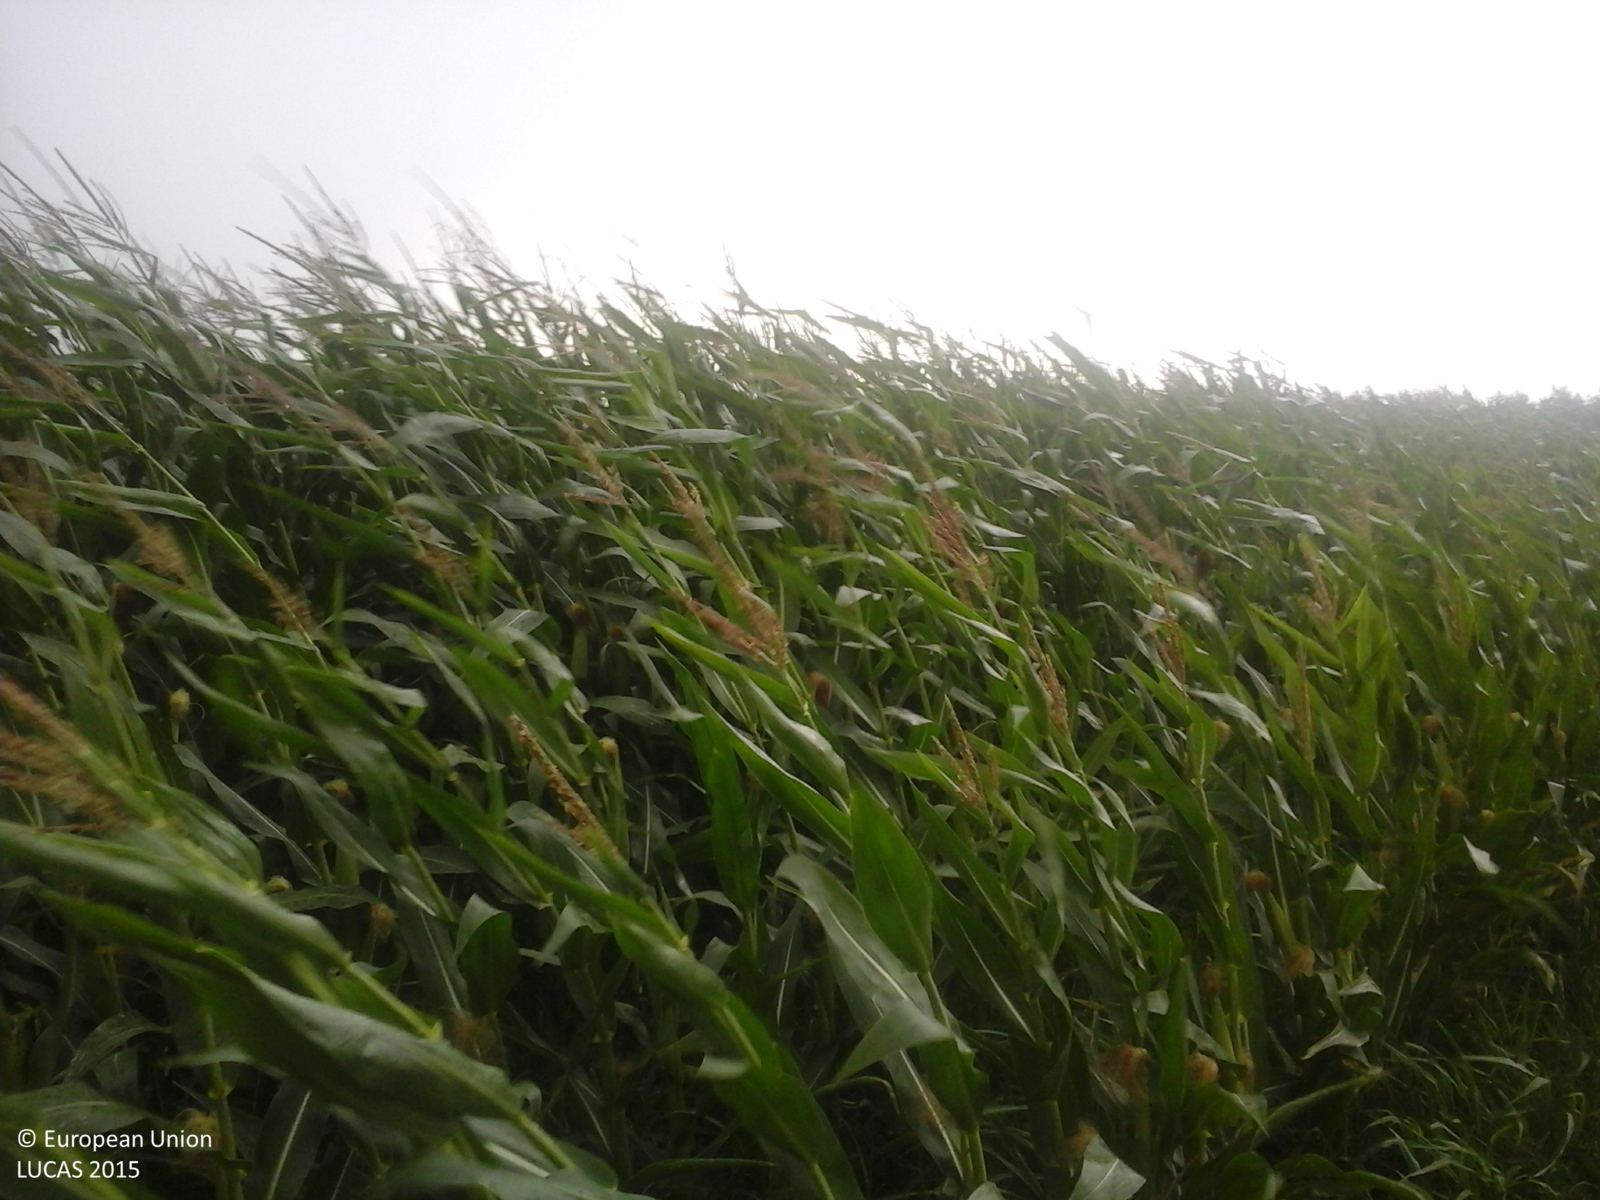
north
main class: Cropland
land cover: Maize
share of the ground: > 75 %
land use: Agriculture (excluding fallow land and kitchen gardens)
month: July
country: RO
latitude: 43.7734
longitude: 25.6802
